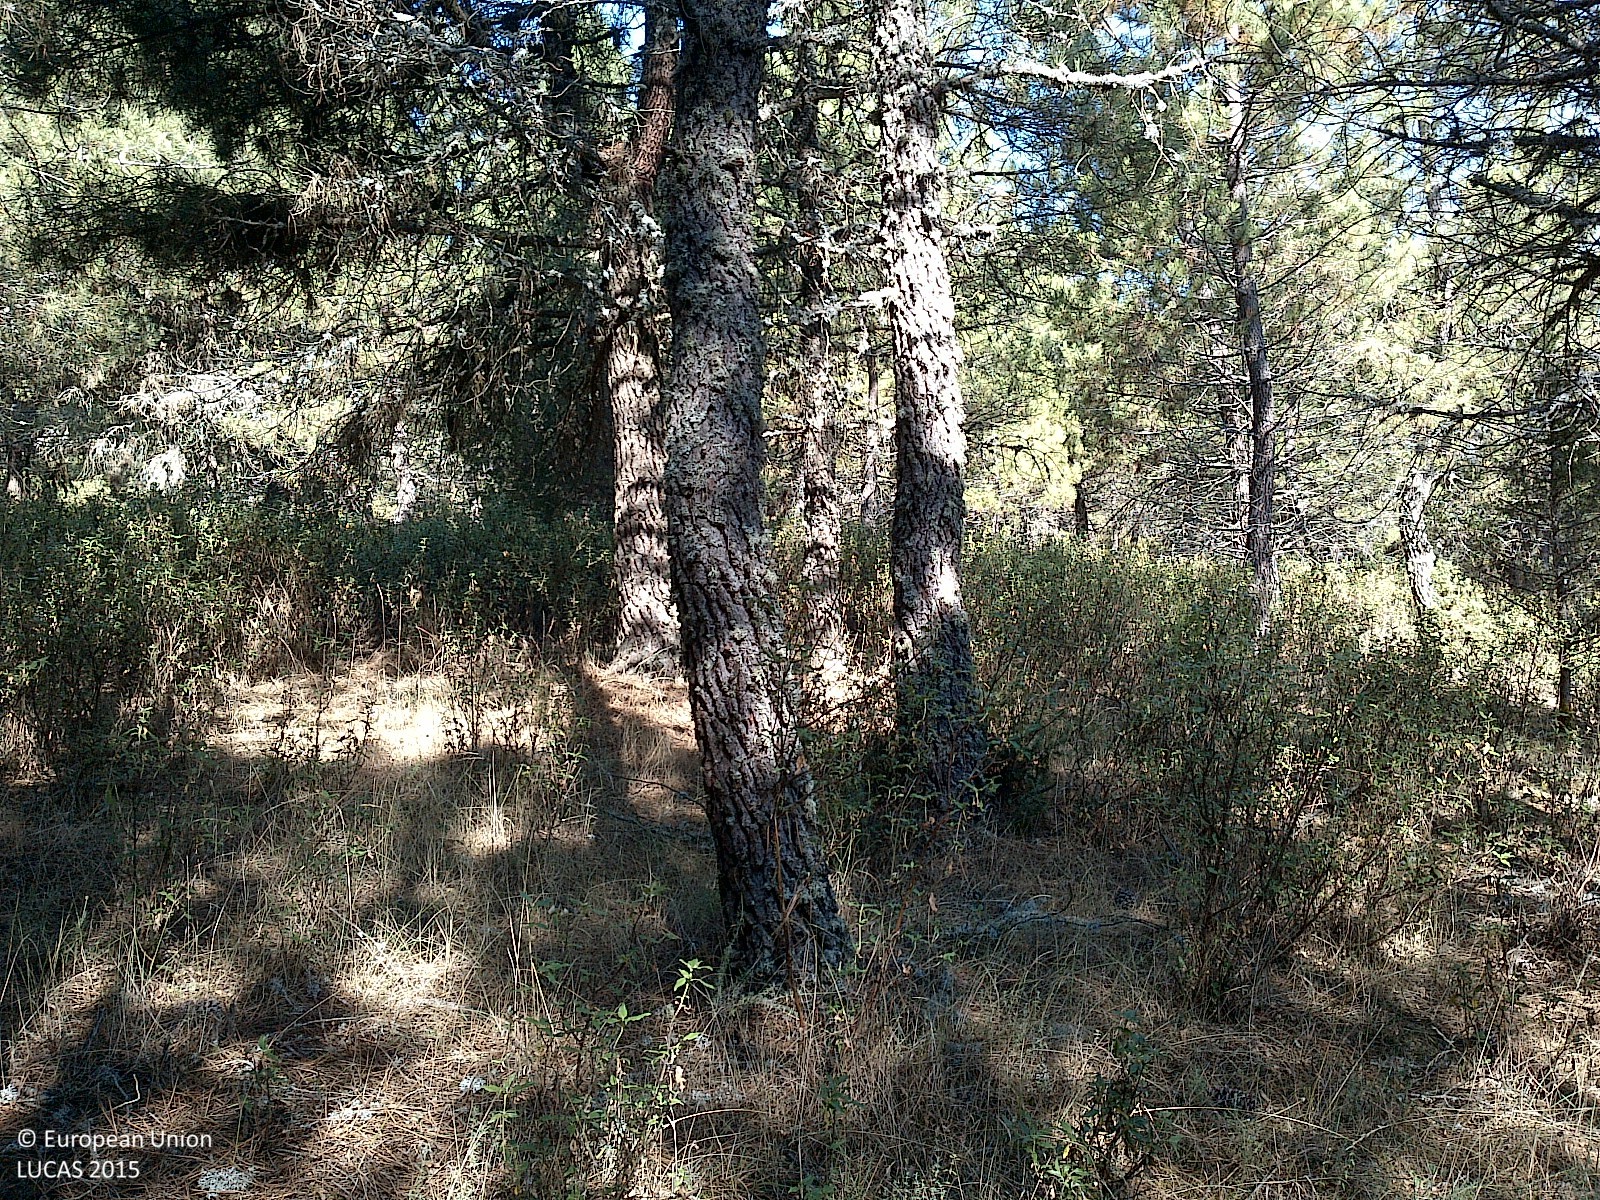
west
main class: Woodland
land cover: Pine dominated coniferous woodland
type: coniferous forest of the mediterranean region
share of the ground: > 75 %
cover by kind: coniferous forest trees 85 %, shrubs 10 %, lichens and mosses 5 %
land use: Forestry
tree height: > 5 m
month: July
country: ES
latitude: 41.7746
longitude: -3.1476
